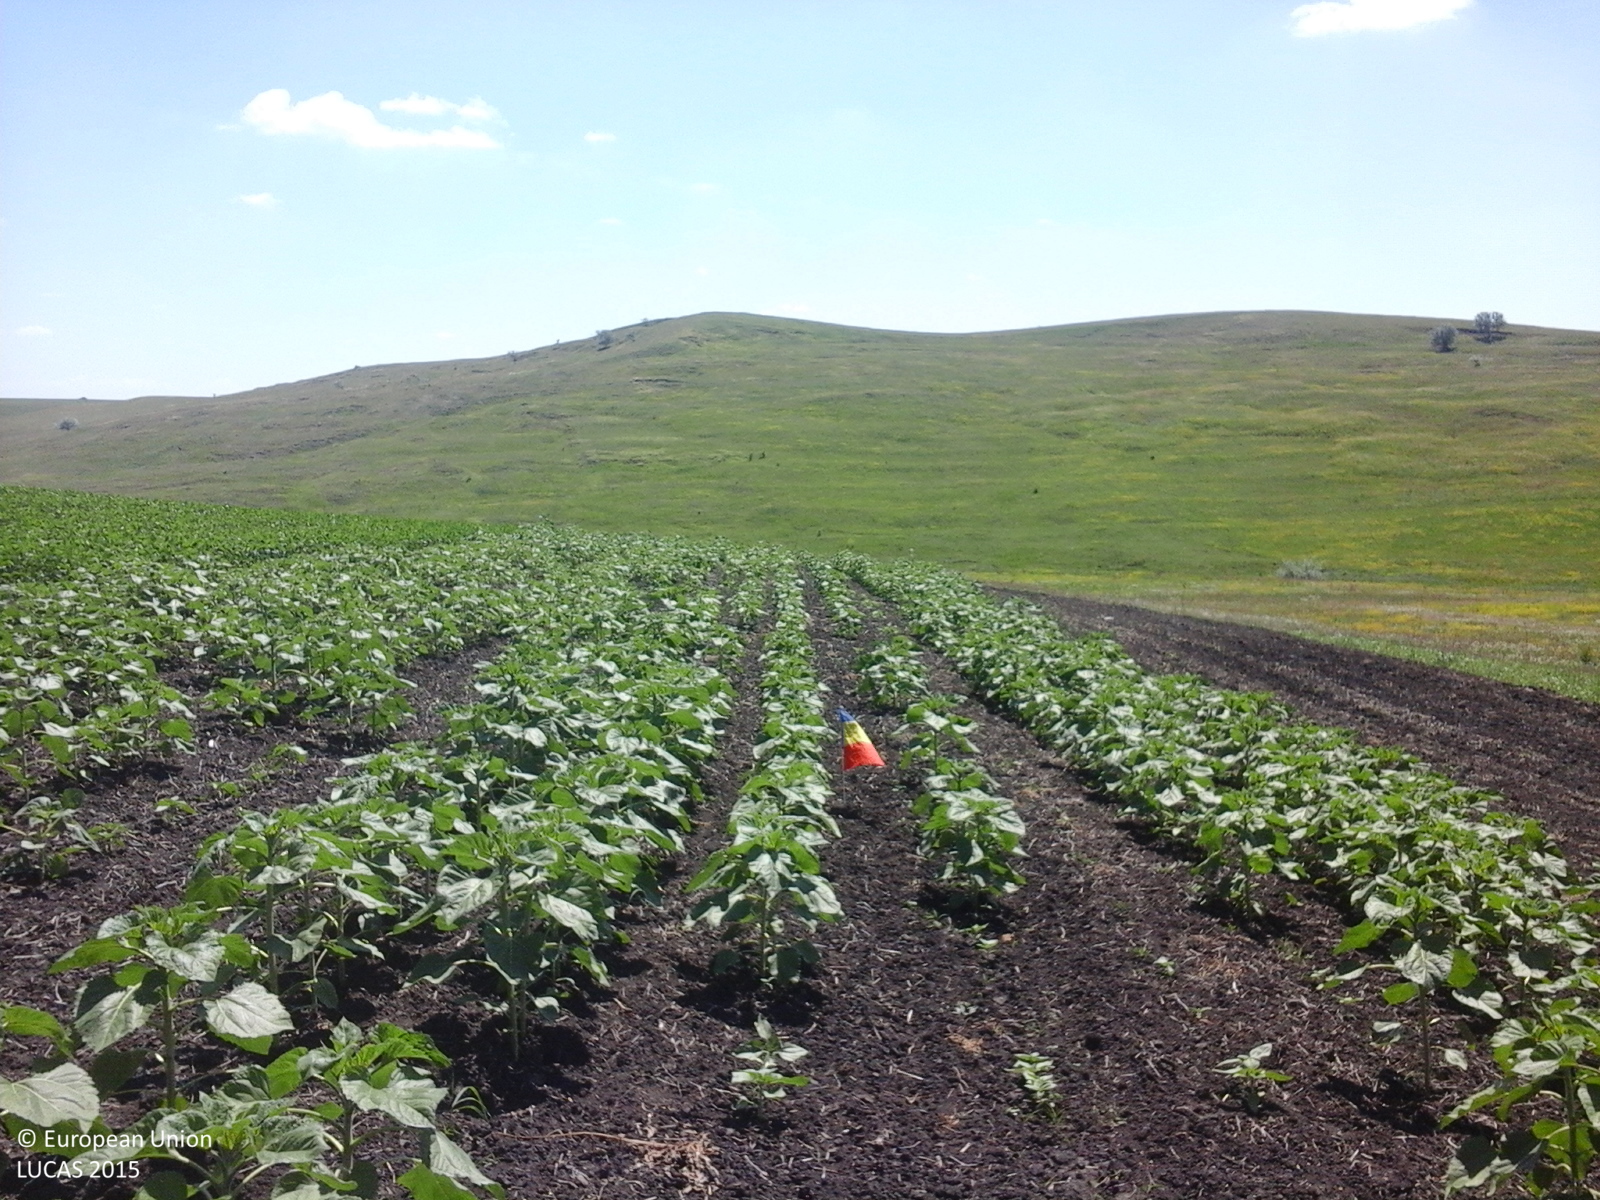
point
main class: Cropland
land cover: Sunflower
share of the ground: 25 - 50 %
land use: Agriculture (excluding fallow land and kitchen gardens)
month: June
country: RO
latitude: 48.1114
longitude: 26.7135
